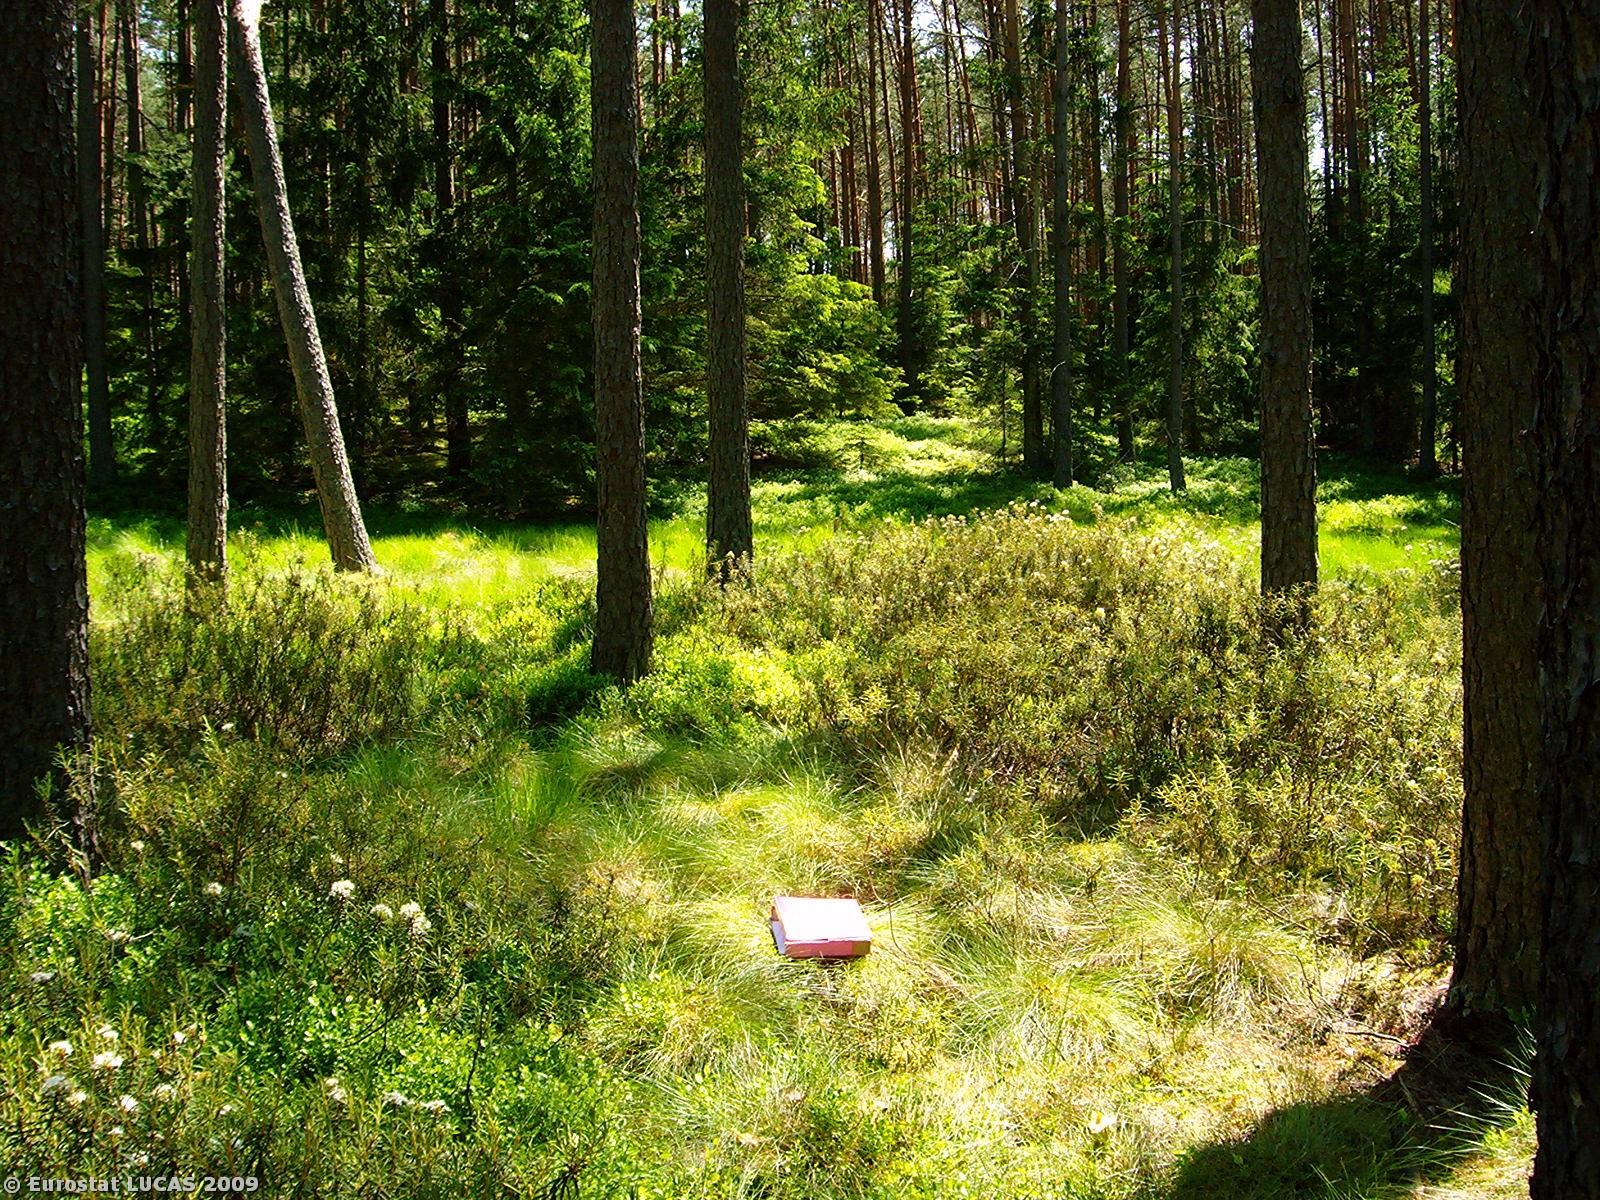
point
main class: Woodland
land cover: Coniferous woodland
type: hemiboreal forest and nemoral coniferous forest and mixed broadleaved-coniferous forest
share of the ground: 50 - 75 %
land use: Forestry
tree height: > 5 m
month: June
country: PL
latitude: 53.9089
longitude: 17.2099
